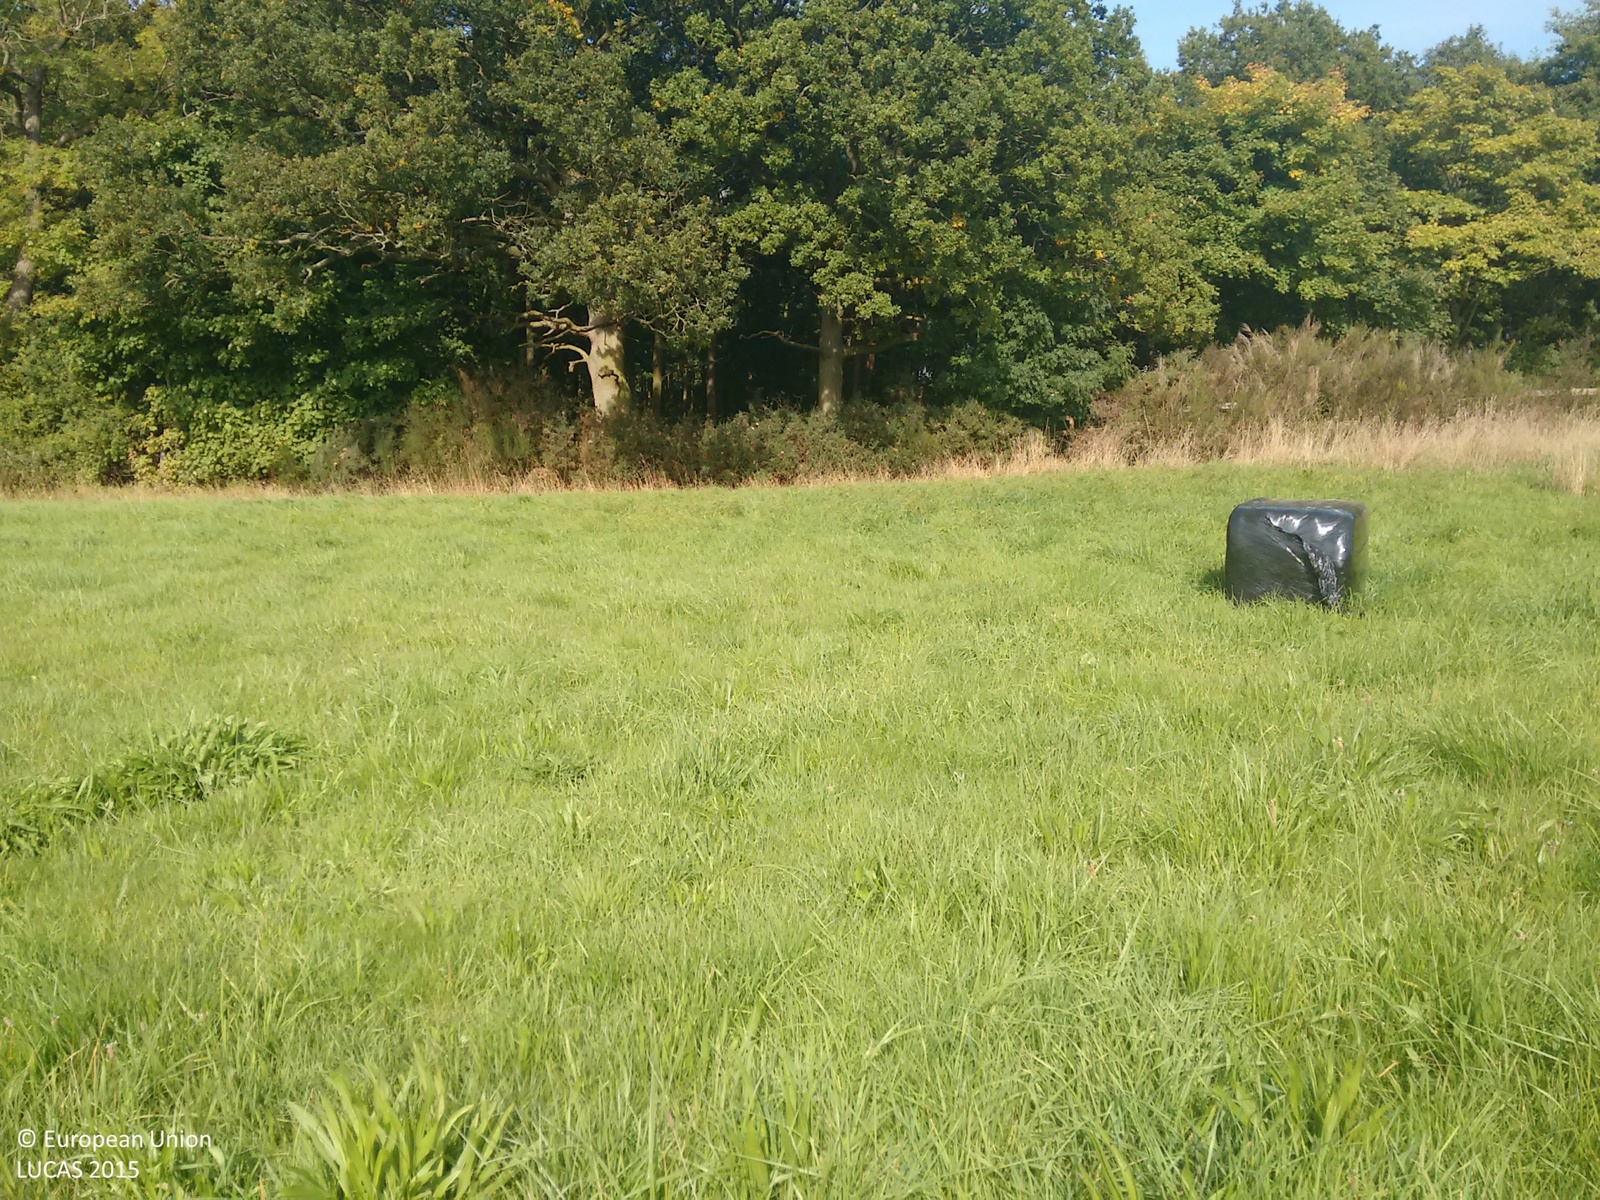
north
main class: Grassland
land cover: Grassland without tree/shrub cover
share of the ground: > 75 %
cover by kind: herbaceous plants 100 %
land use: Agriculture (excluding fallow land and kitchen gardens)
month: September
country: GB
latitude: 52.8081
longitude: -2.3016
